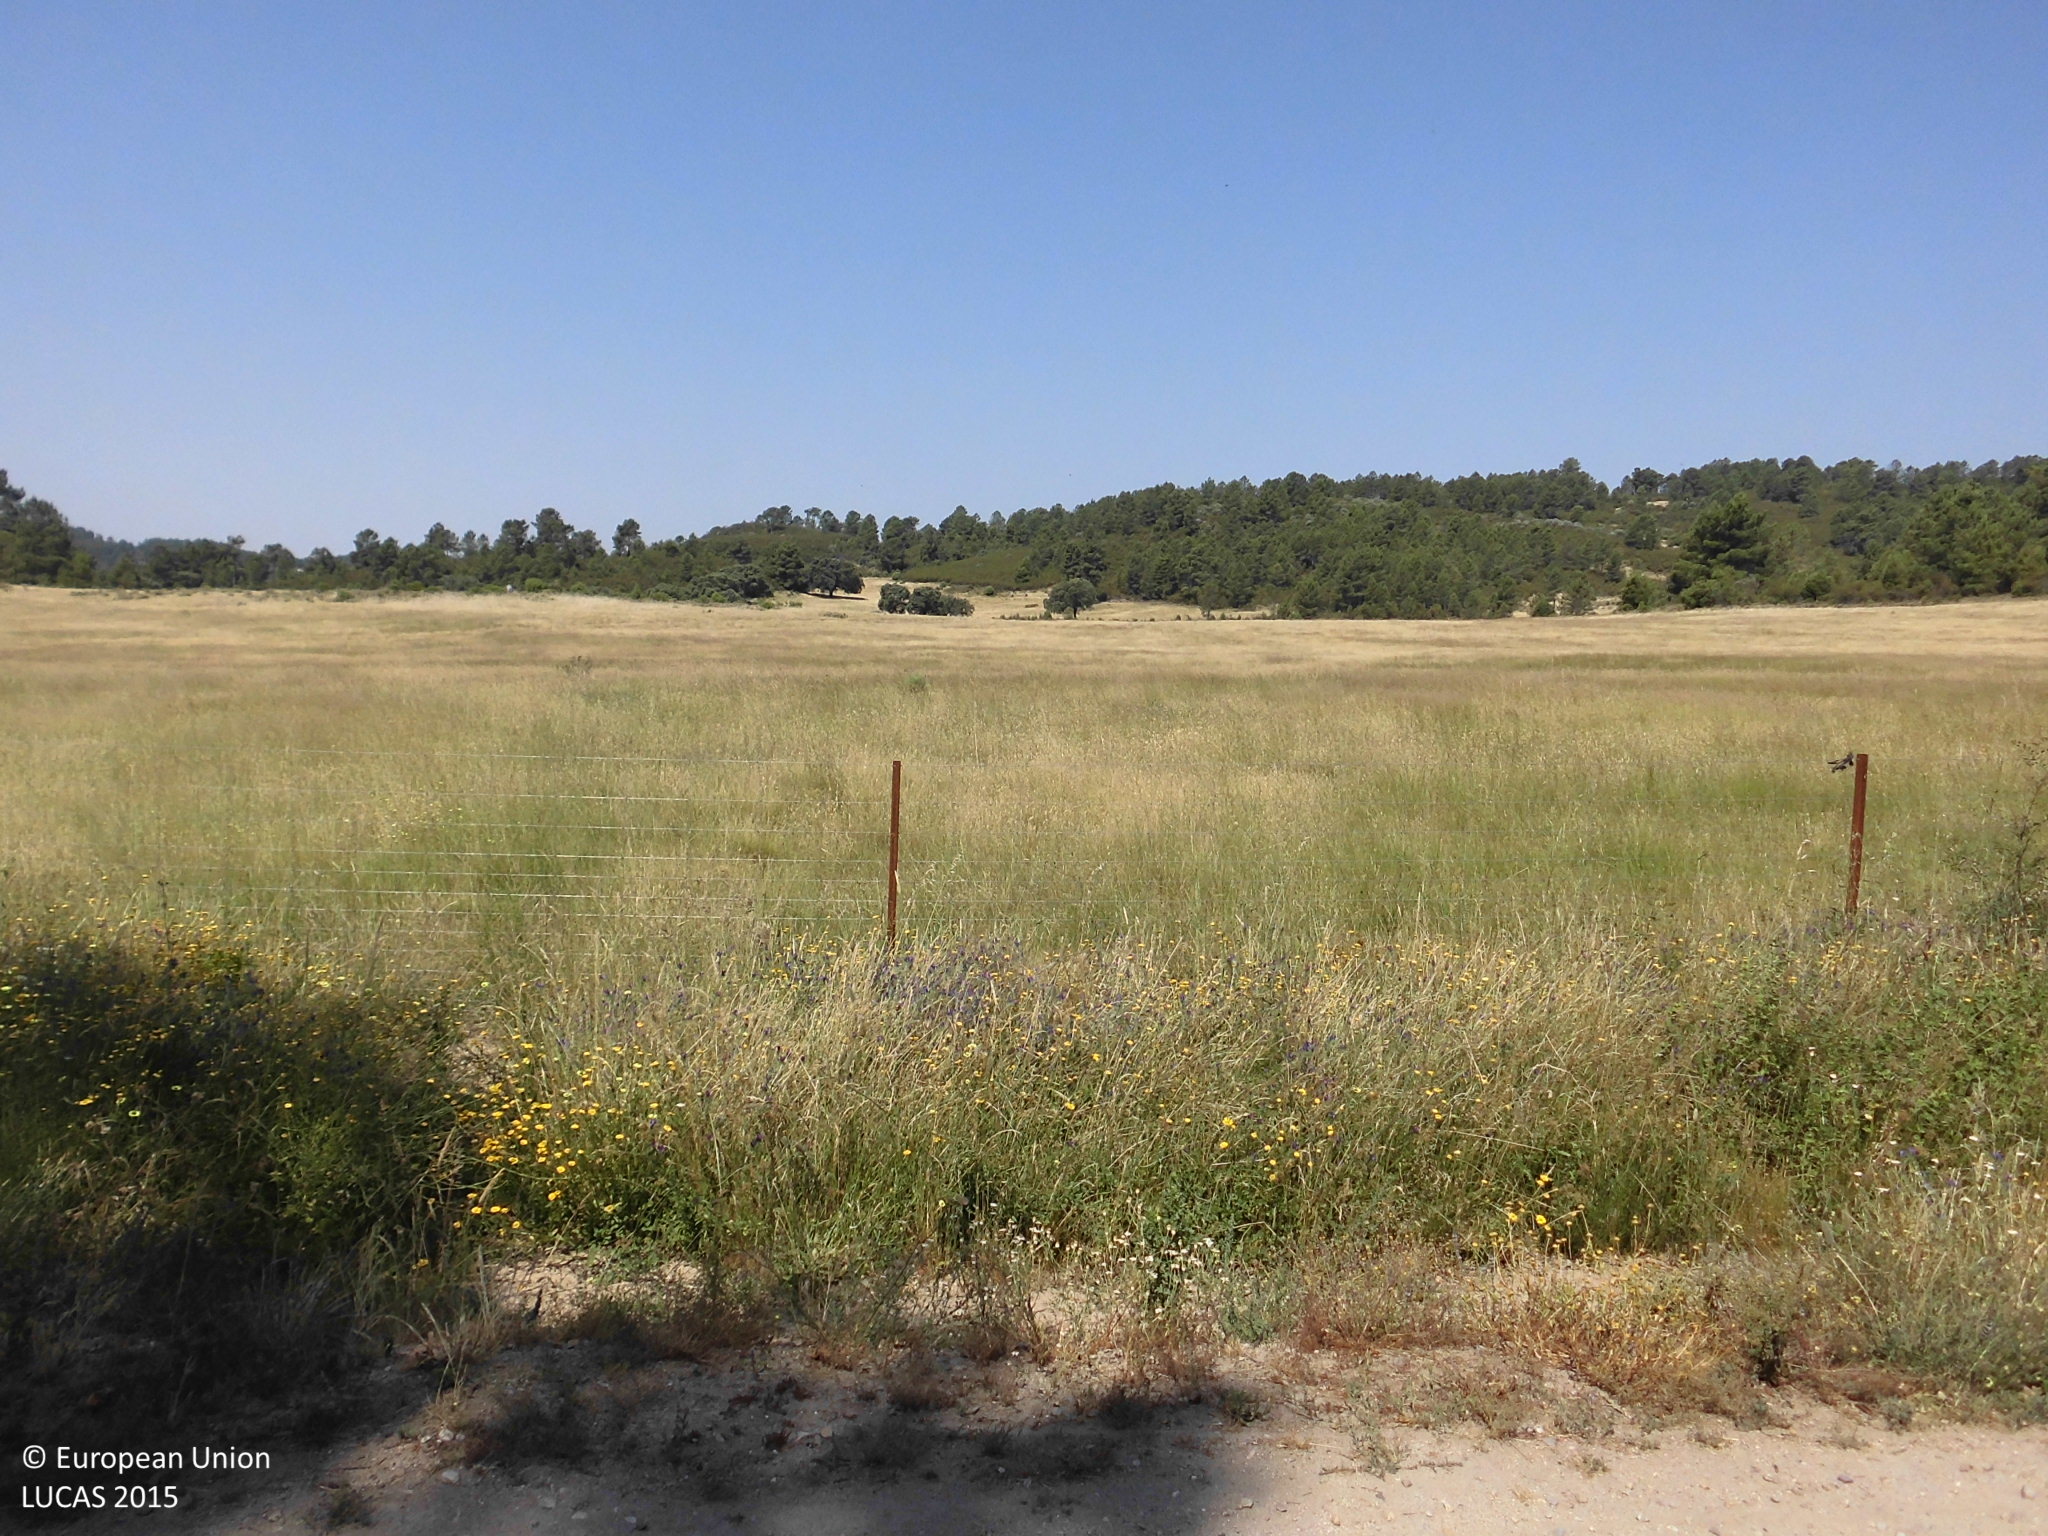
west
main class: Shrubland
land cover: Shrubland with sparse tree cover
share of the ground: 25 - 50 %
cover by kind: herbaceous plants 50 %, shrubs 45 %, broadleaved forest trees 5 %
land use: Agriculture (excluding fallow land and kitchen gardens)
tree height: > 5 m
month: June
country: ES
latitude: 40.1029
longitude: -5.4395
